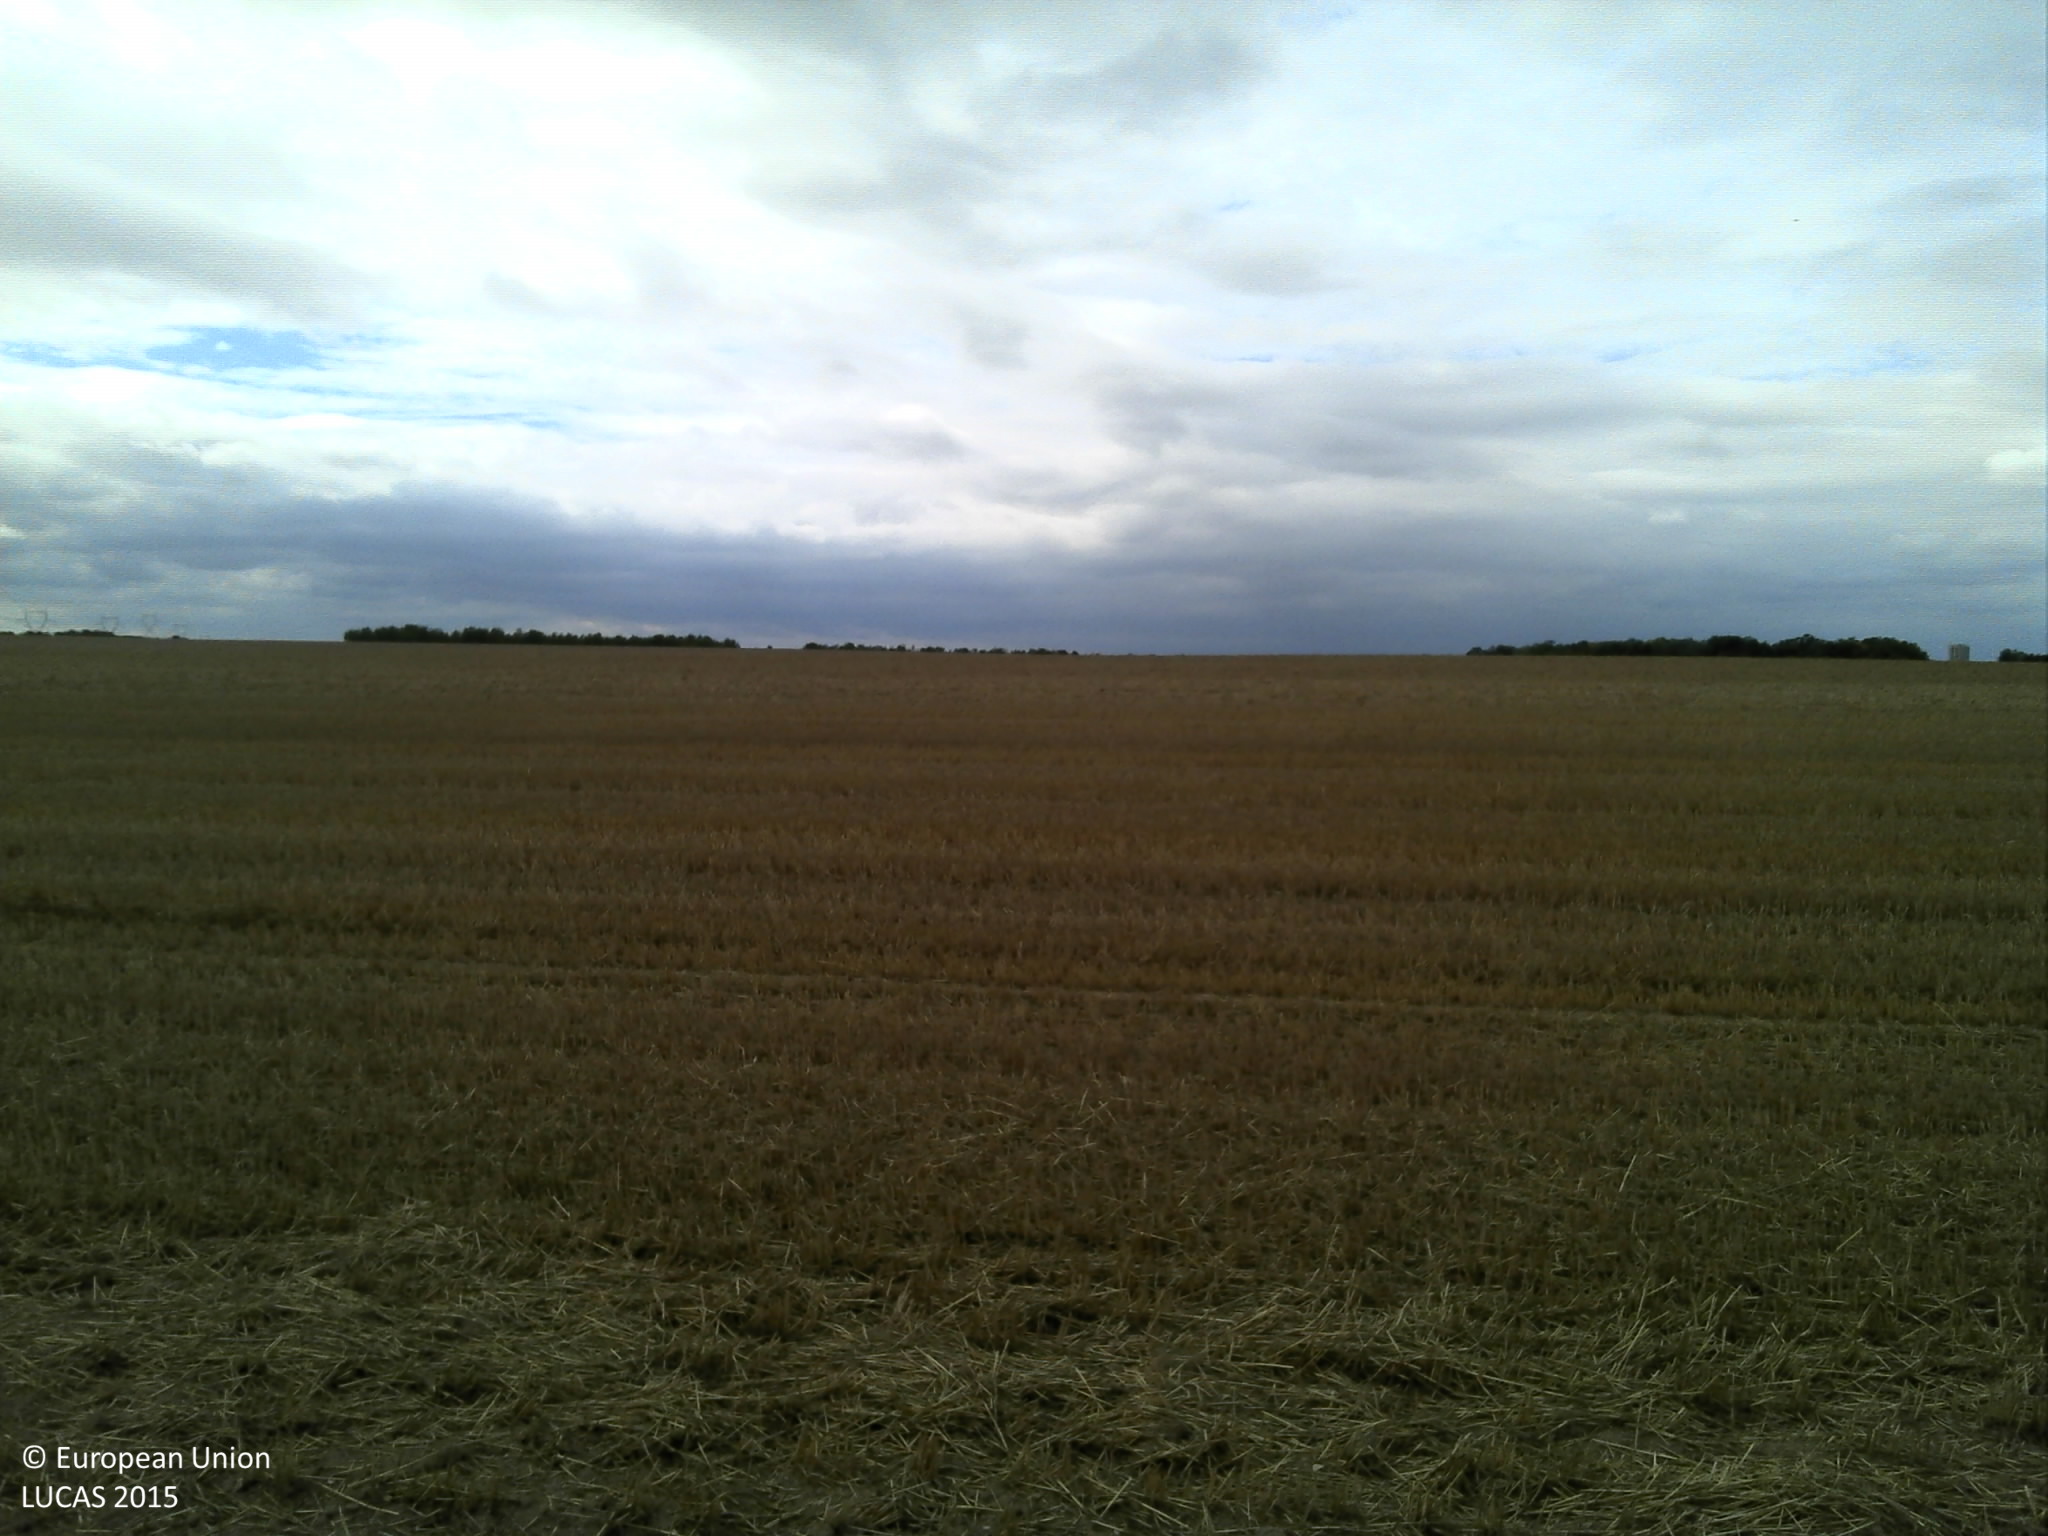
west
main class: Cropland
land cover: Common wheat
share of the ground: > 75 %
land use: Agriculture (excluding fallow land and kitchen gardens)
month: August
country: FR
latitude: 48.5212
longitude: 4.1879
